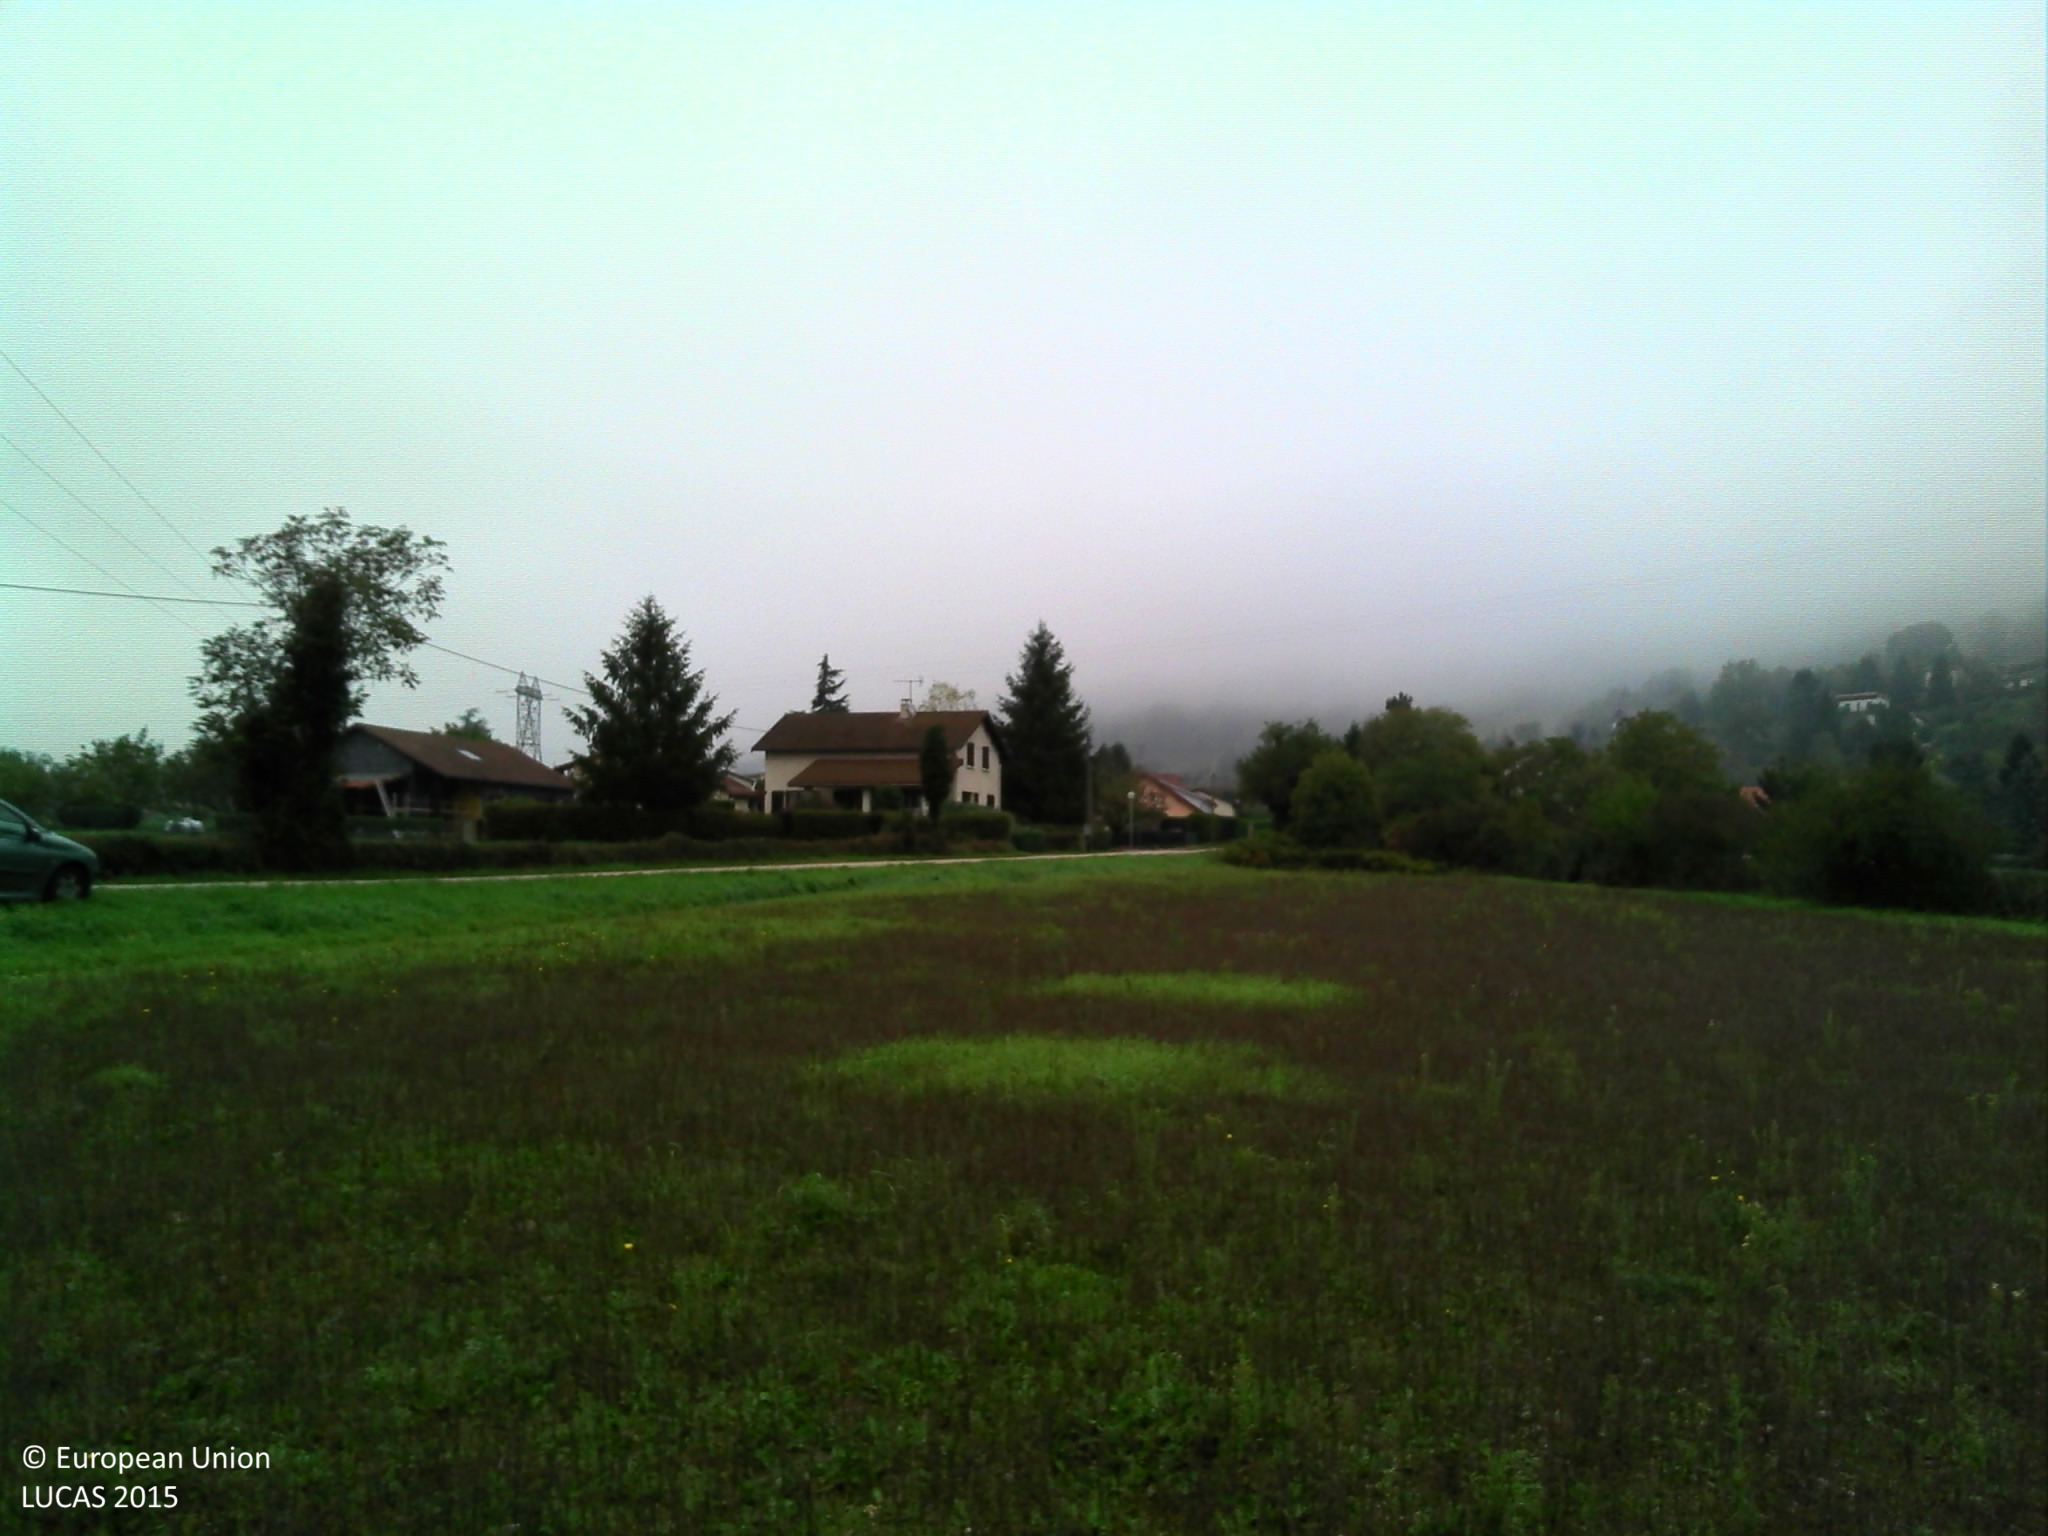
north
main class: Grassland
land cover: Spontaneously vegetated surfaces
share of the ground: > 75 %
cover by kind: herbaceous plants 100 %
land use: Agriculture (excluding fallow land and kitchen gardens)
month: October
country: FR
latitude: 45.8387
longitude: 5.4332
